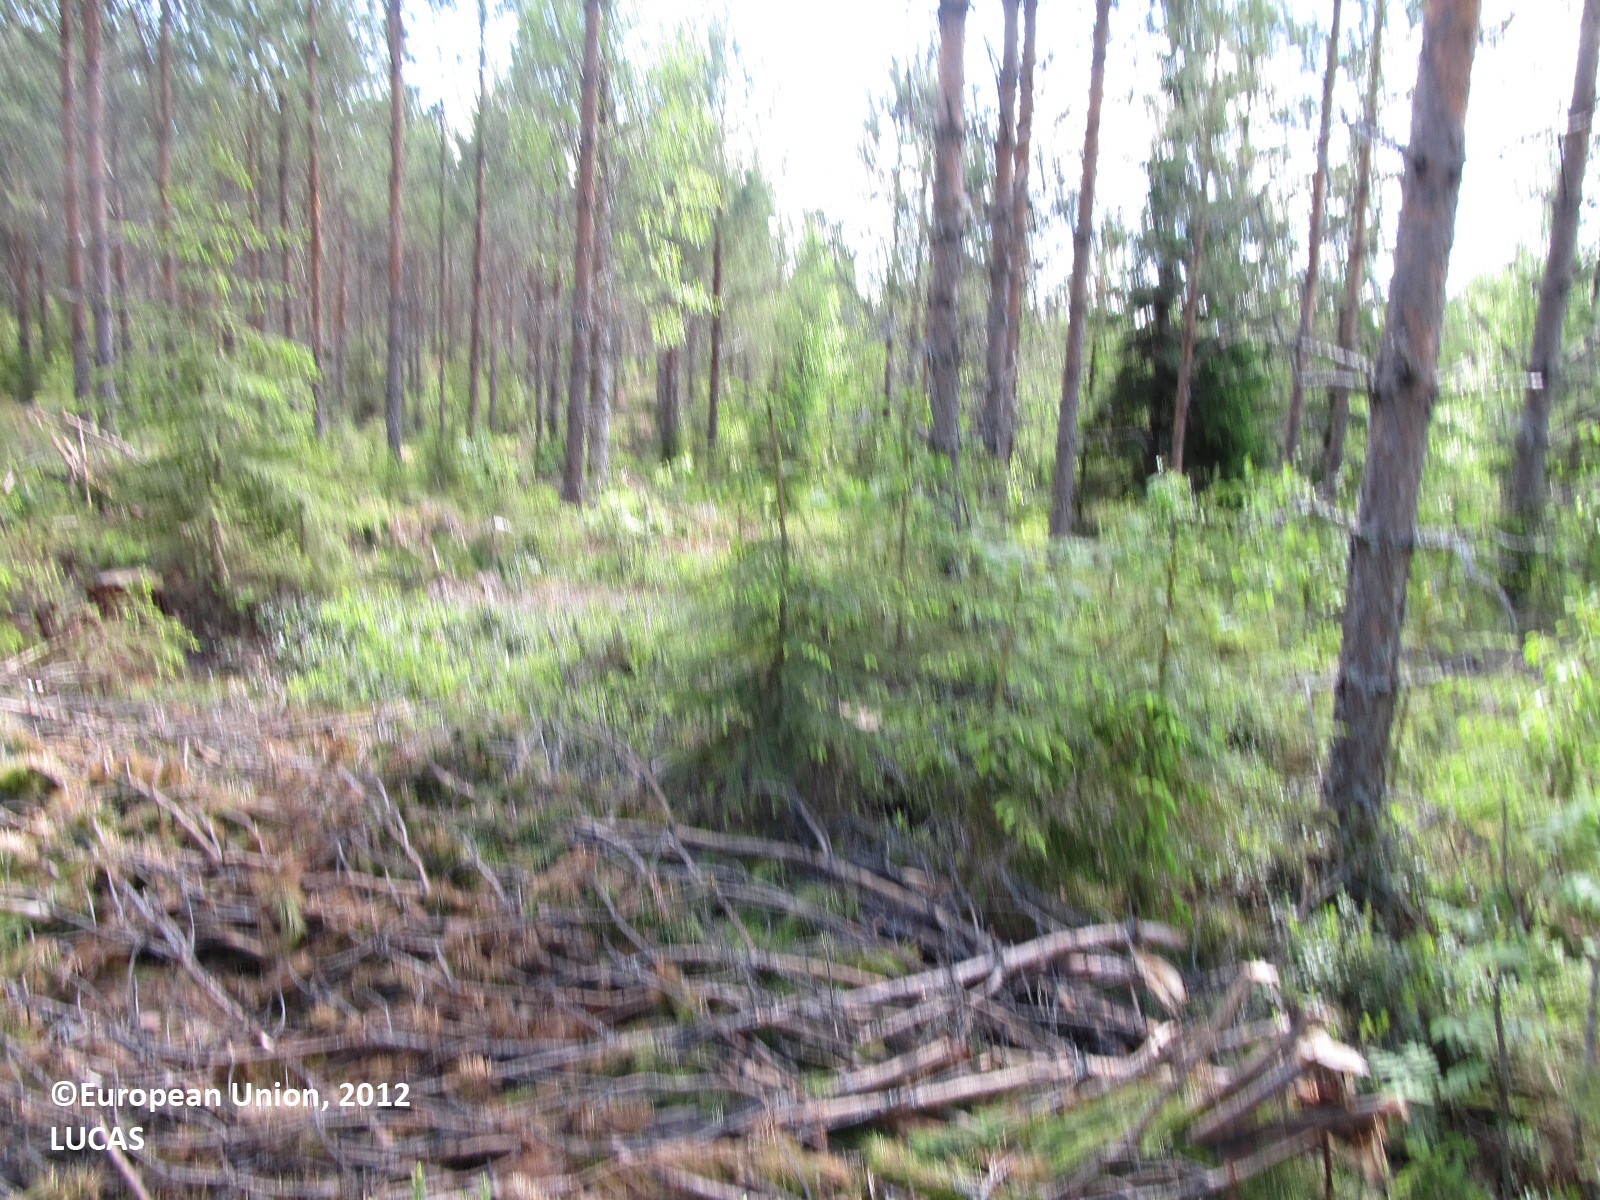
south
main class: Woodland
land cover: Pine dominated coniferous woodland
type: boreal forest
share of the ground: 25 - 50 %
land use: Forestry
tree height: > 5 m
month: June
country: FI
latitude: 62.7193
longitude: 27.5520
